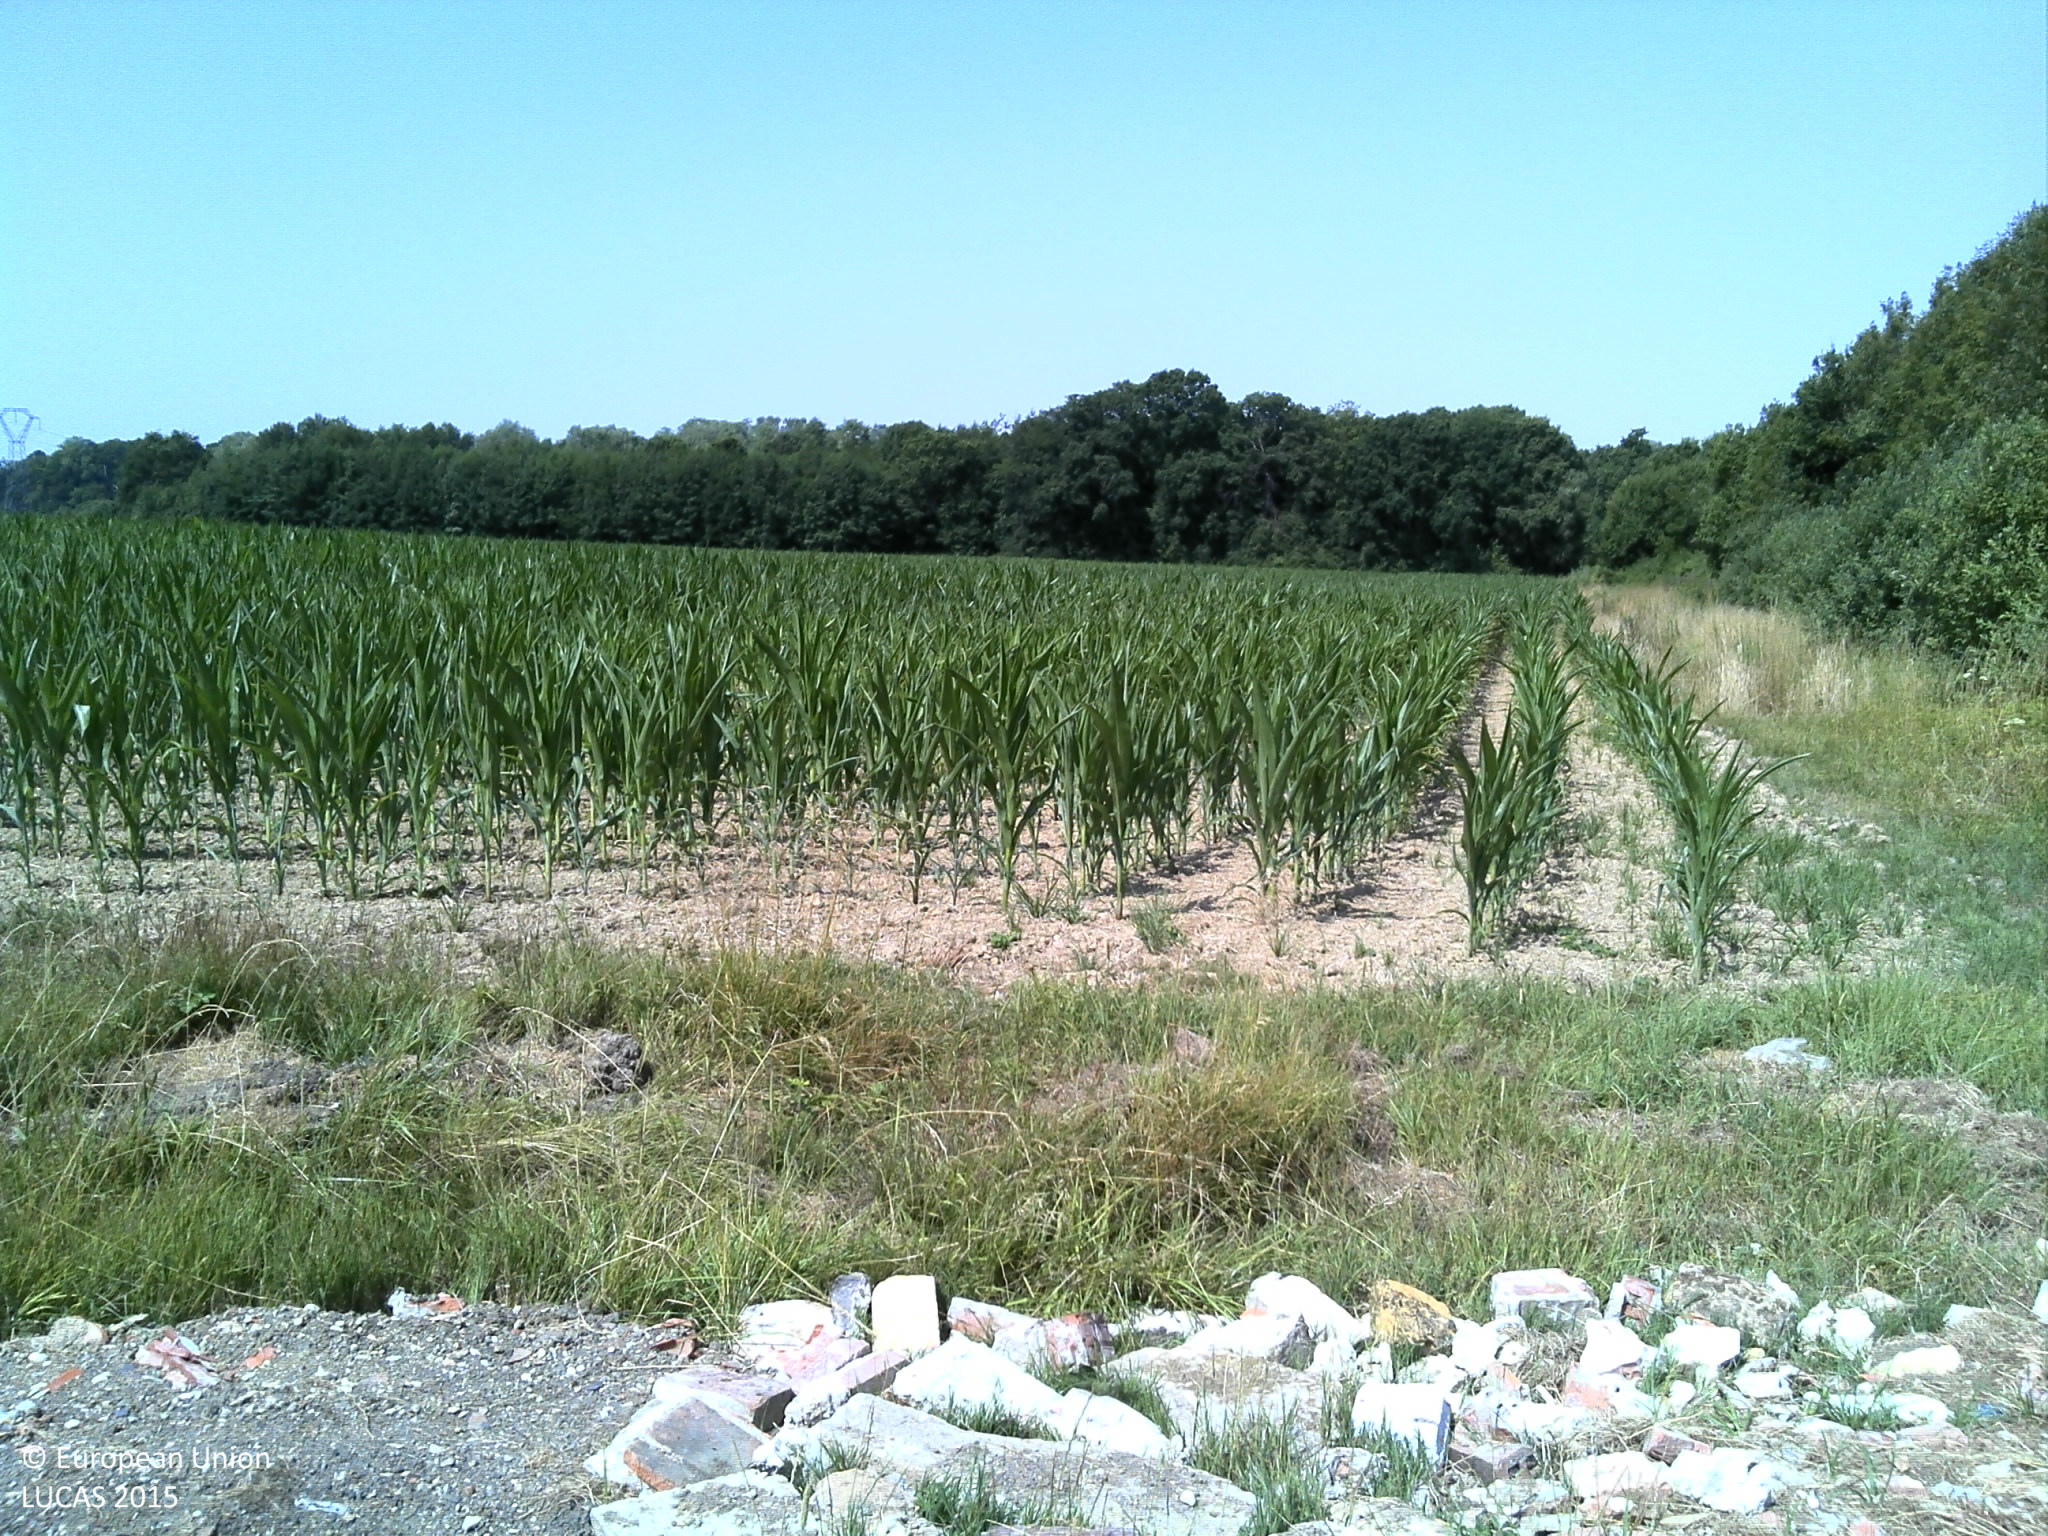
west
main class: Grassland
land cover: Grassland without tree/shrub cover
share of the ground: > 75 %
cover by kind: herbaceous plants 100 %
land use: Agriculture (excluding fallow land and kitchen gardens)
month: July
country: FR
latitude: 48.8249
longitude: 4.8626
